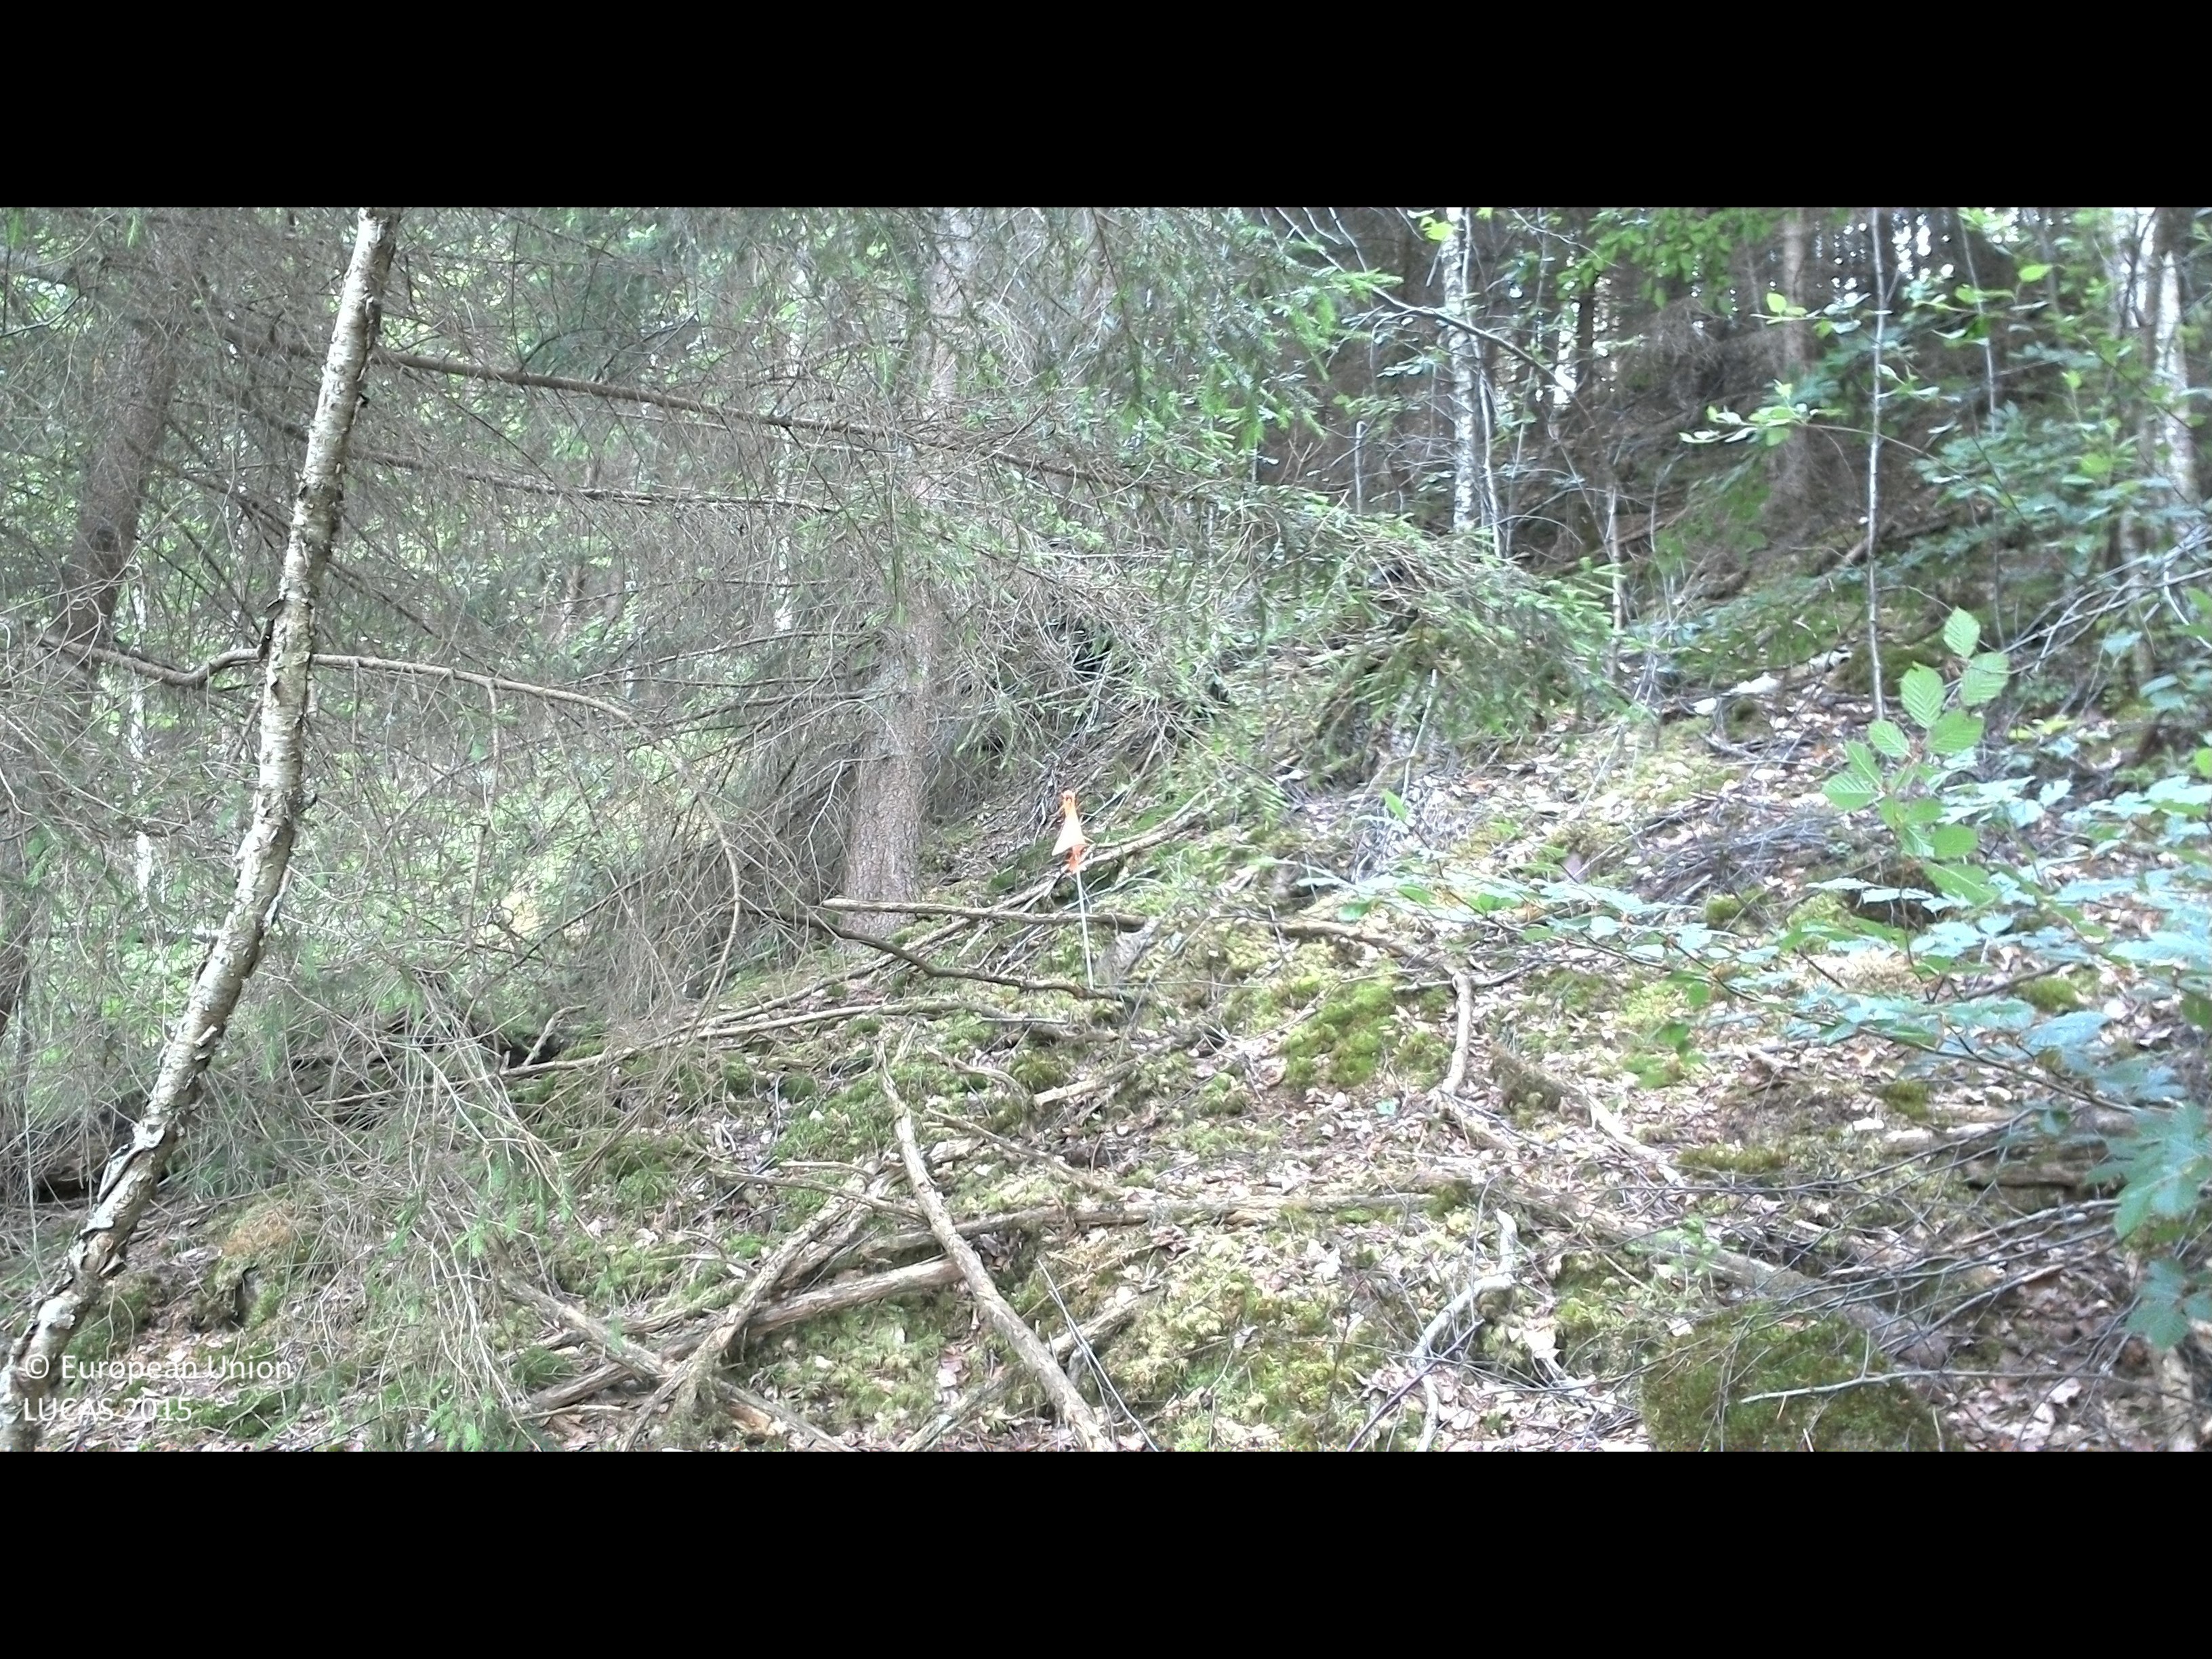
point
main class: Woodland
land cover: Spruce dominated coniferous woodland
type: boreal forest
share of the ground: > 75 %
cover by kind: coniferous forest trees 75 %, broadleaved forest trees 10 %, lichens and mosses 10 %, herbaceous plants 5 %
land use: Forestry
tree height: > 5 m
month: July
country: SE
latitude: 56.4144
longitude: 15.0068
